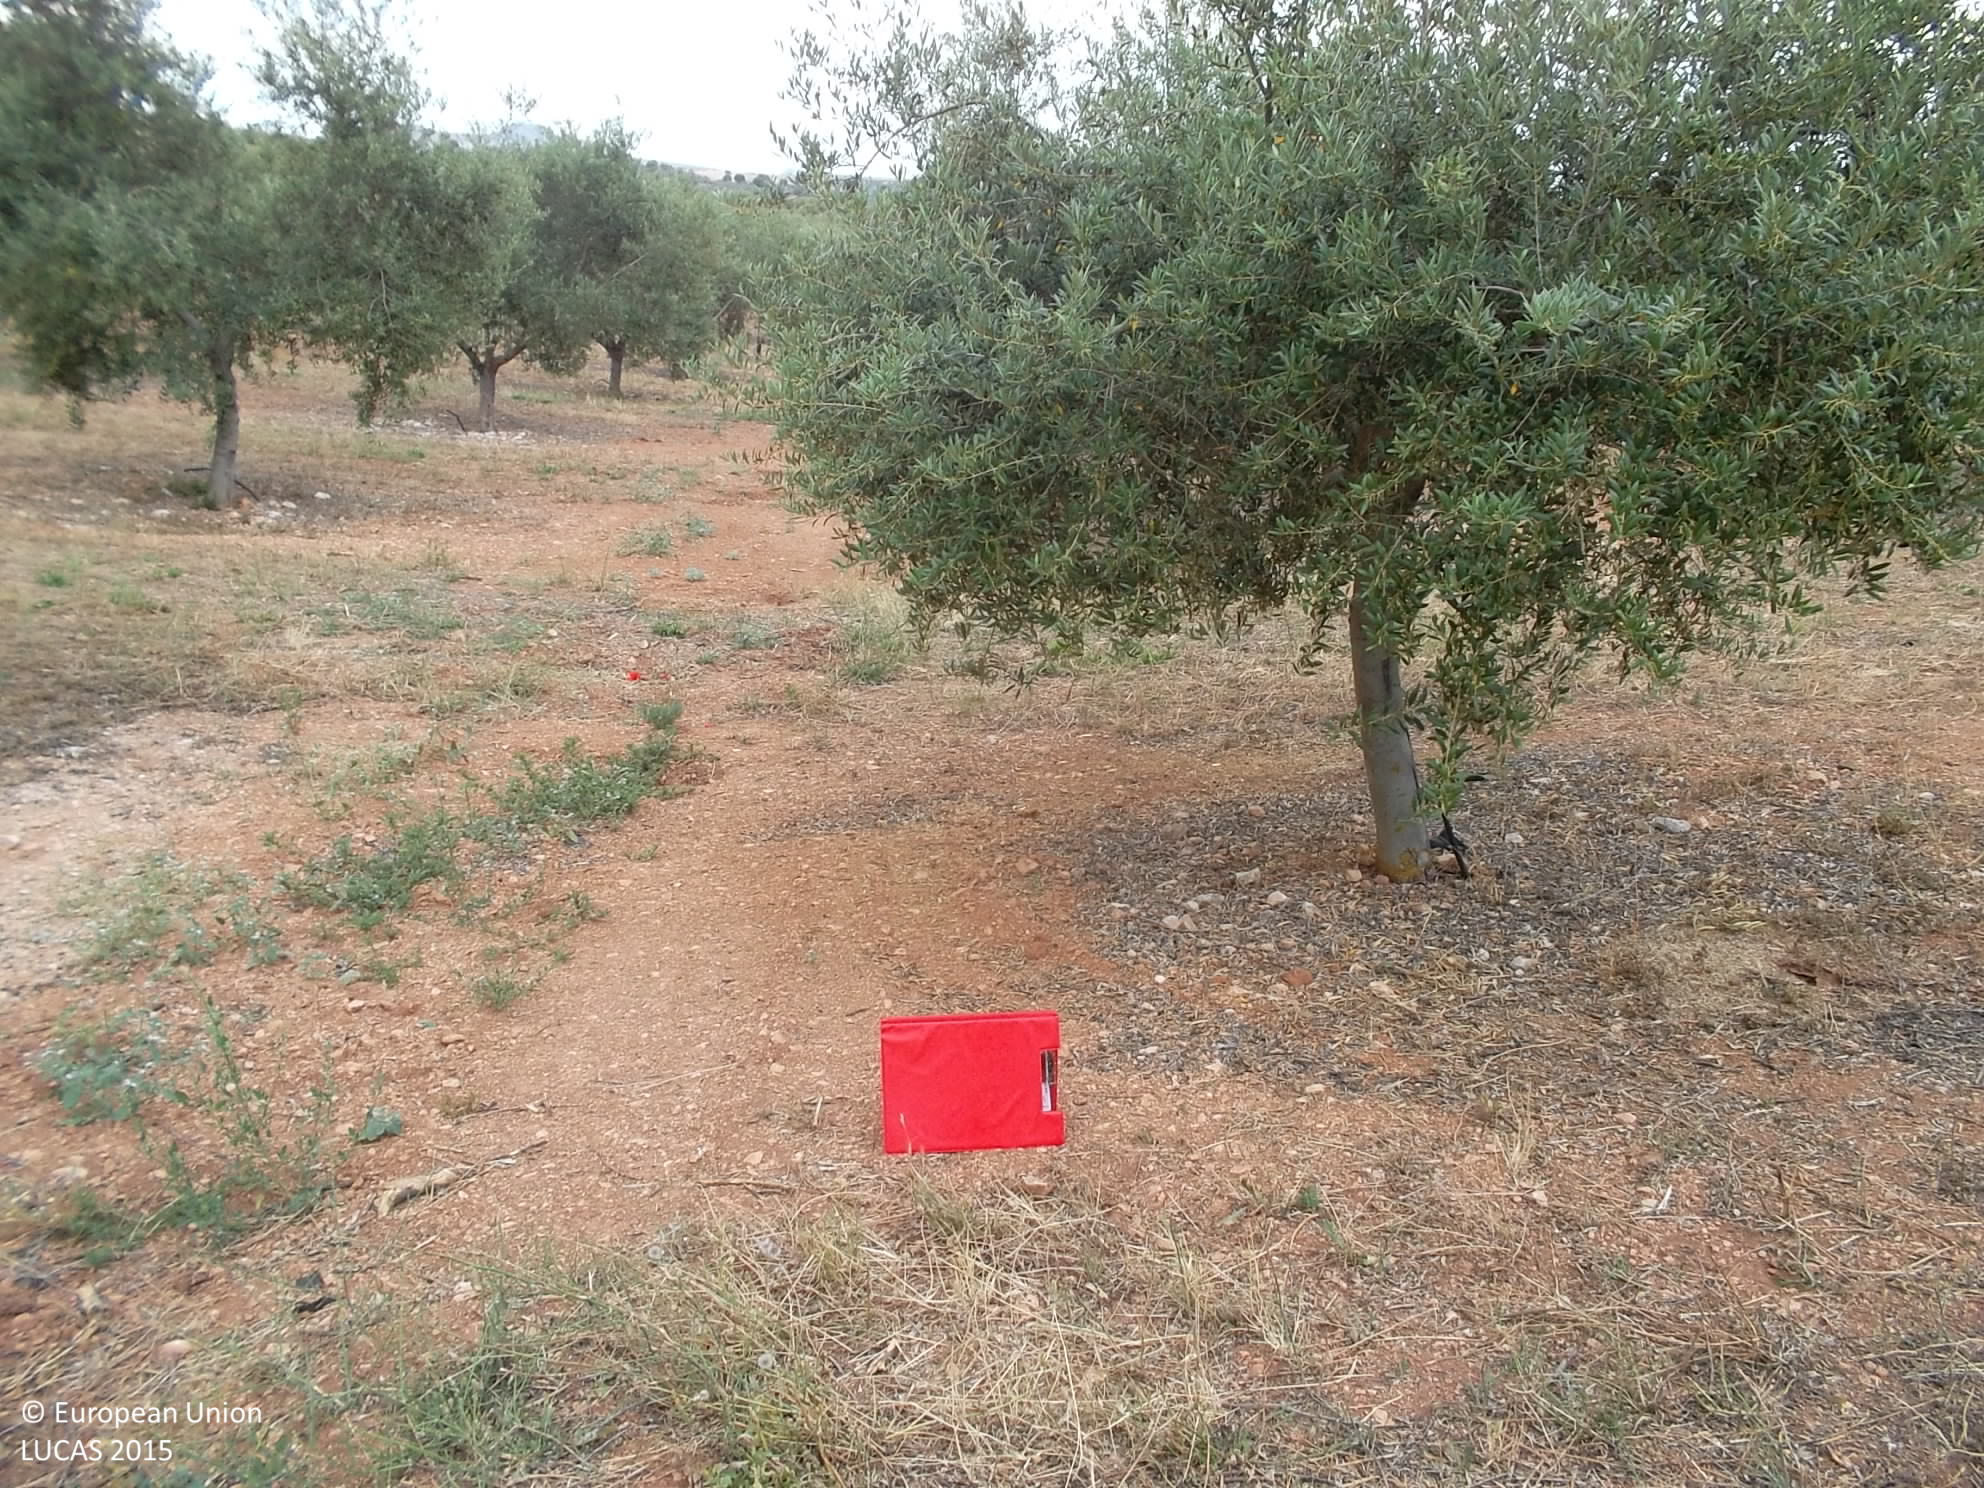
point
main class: Cropland
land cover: Olive groves
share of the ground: 25 - 50 %
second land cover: Other bare soil
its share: > 75 %
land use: Agriculture (excluding fallow land and kitchen gardens)
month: June
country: ES
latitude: 37.5945
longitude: -3.3238
